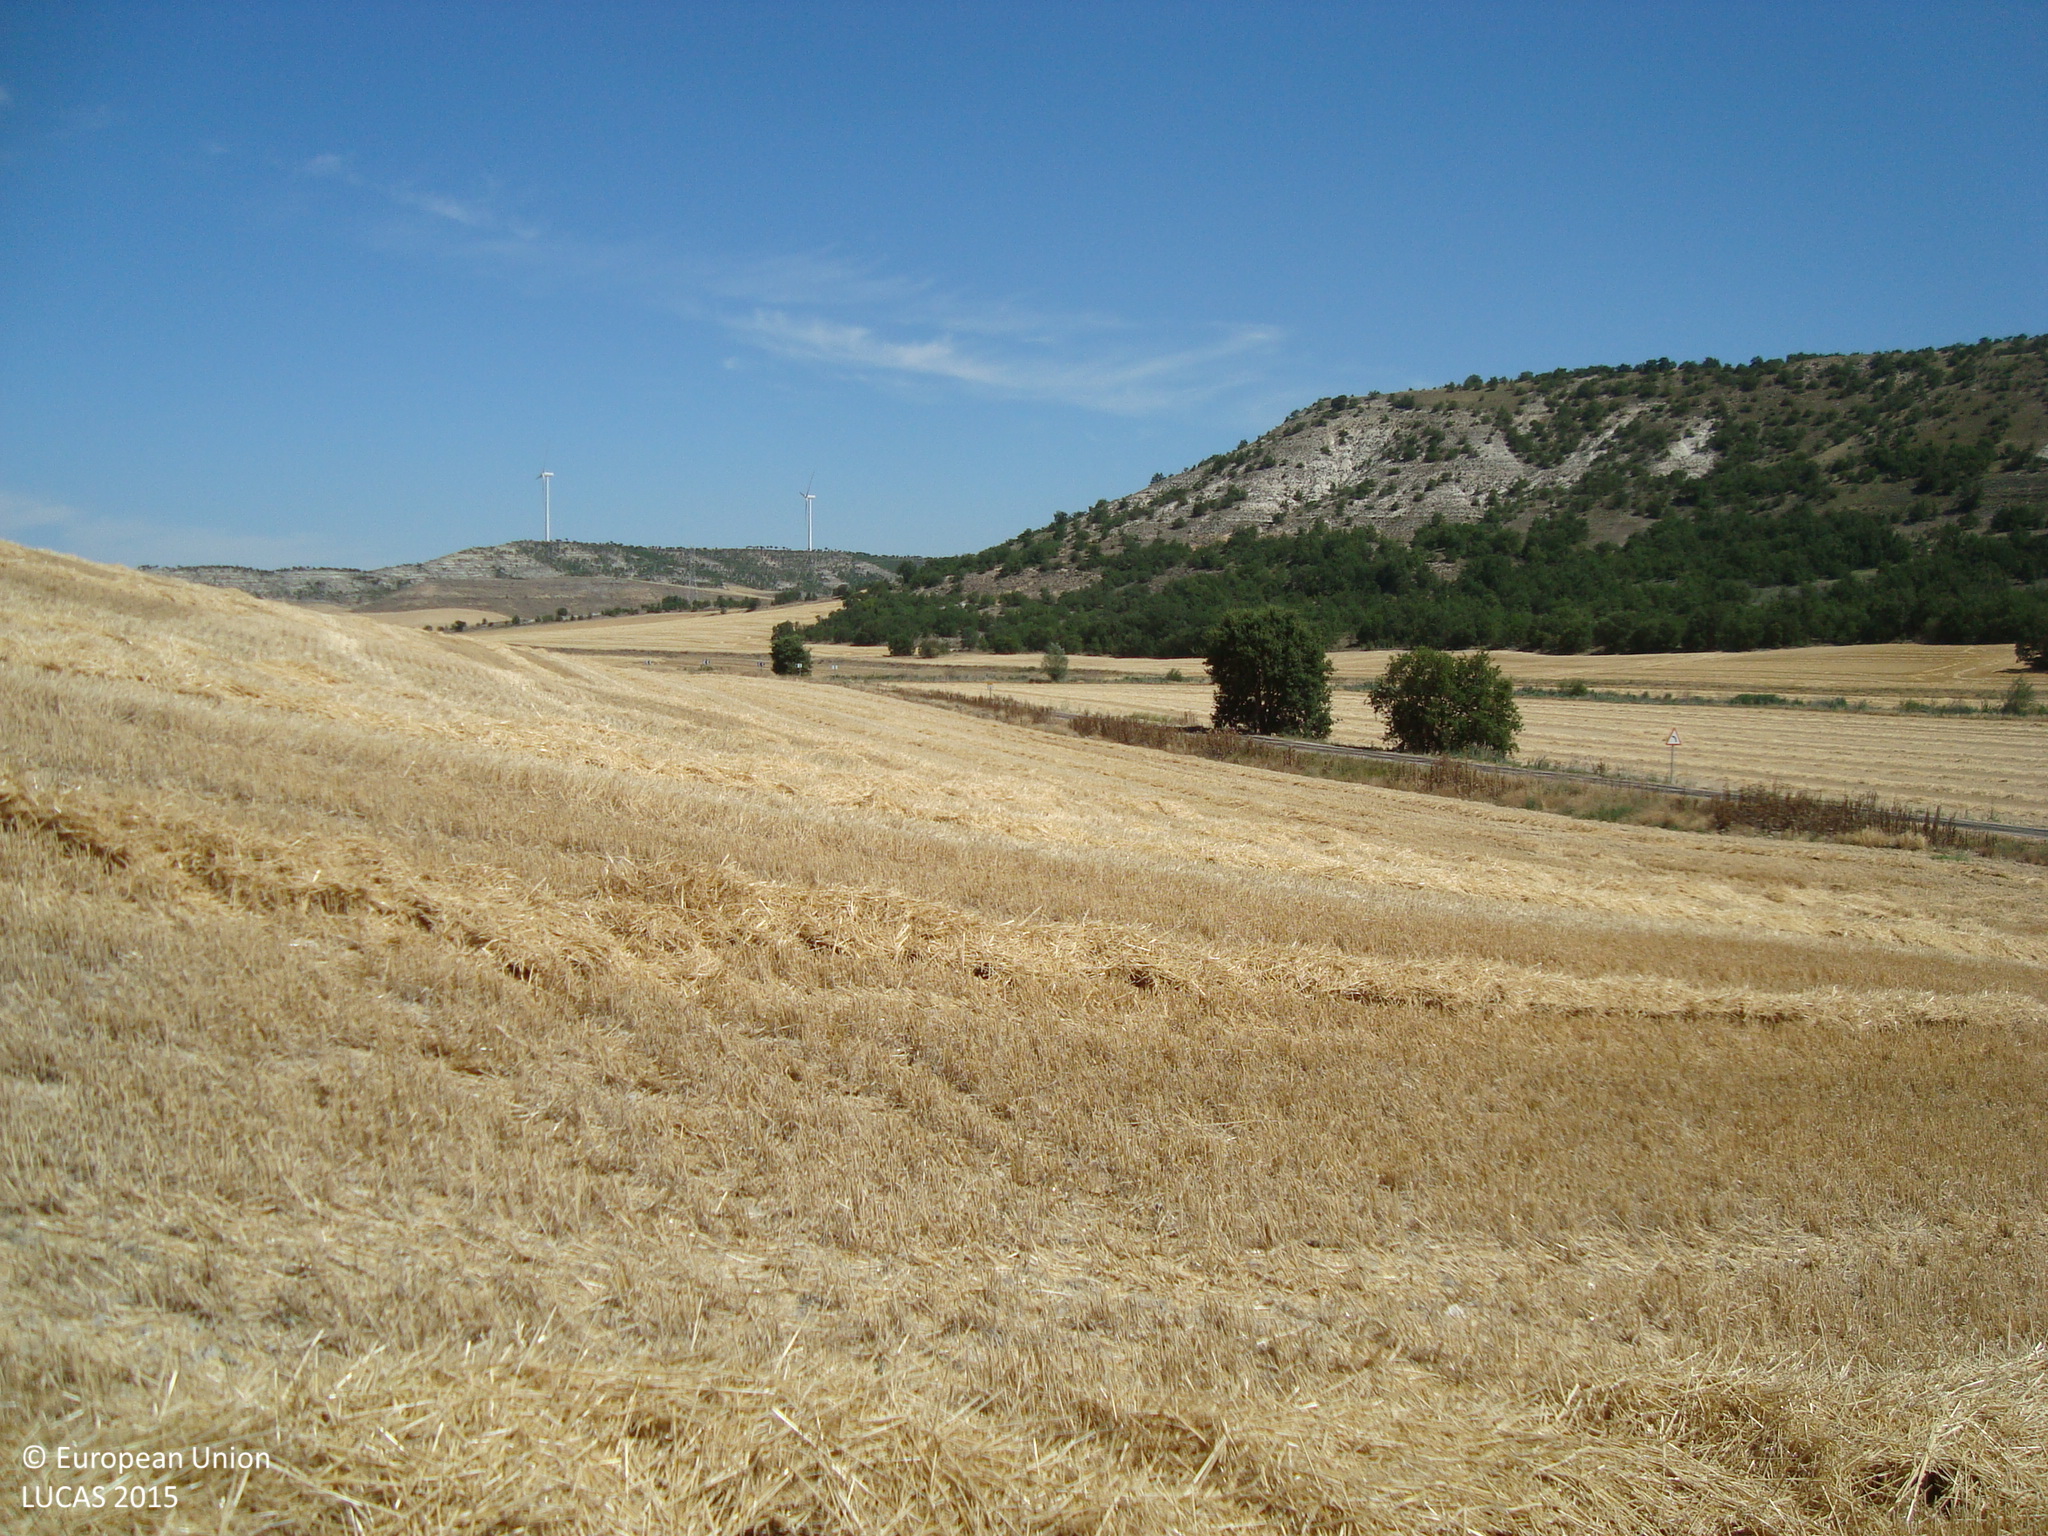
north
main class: Cropland
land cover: Common wheat
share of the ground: > 75 %
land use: Agriculture (excluding fallow land and kitchen gardens)
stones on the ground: 10 - 25 %
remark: Harvested field
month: July
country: ES
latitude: 42.0099
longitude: -4.2287
